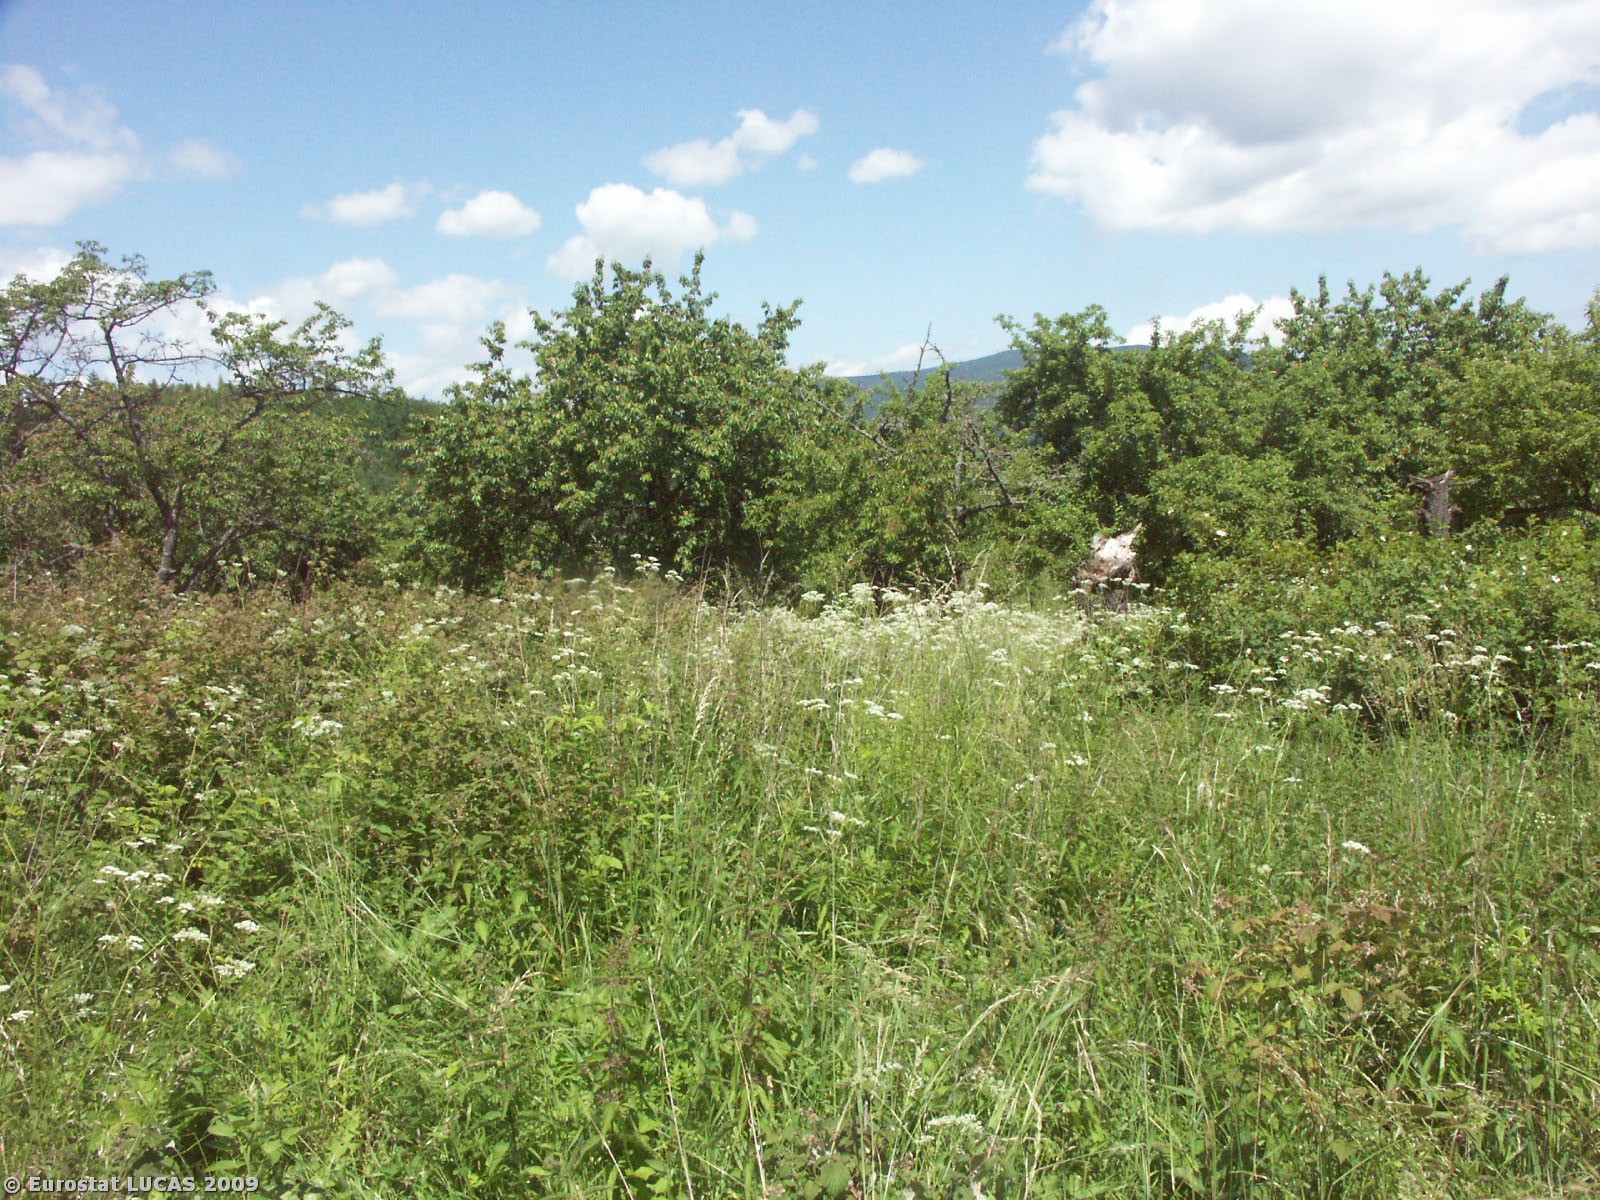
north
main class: Cropland
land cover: Cherry fruit
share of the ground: 10 - 25 %
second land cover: Shrubland with sparse tree cover
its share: > 75 %
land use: Agriculture (excluding fallow land and kitchen gardens)
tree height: > 5 m
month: June
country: CZ
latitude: 48.8068
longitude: 14.2897
